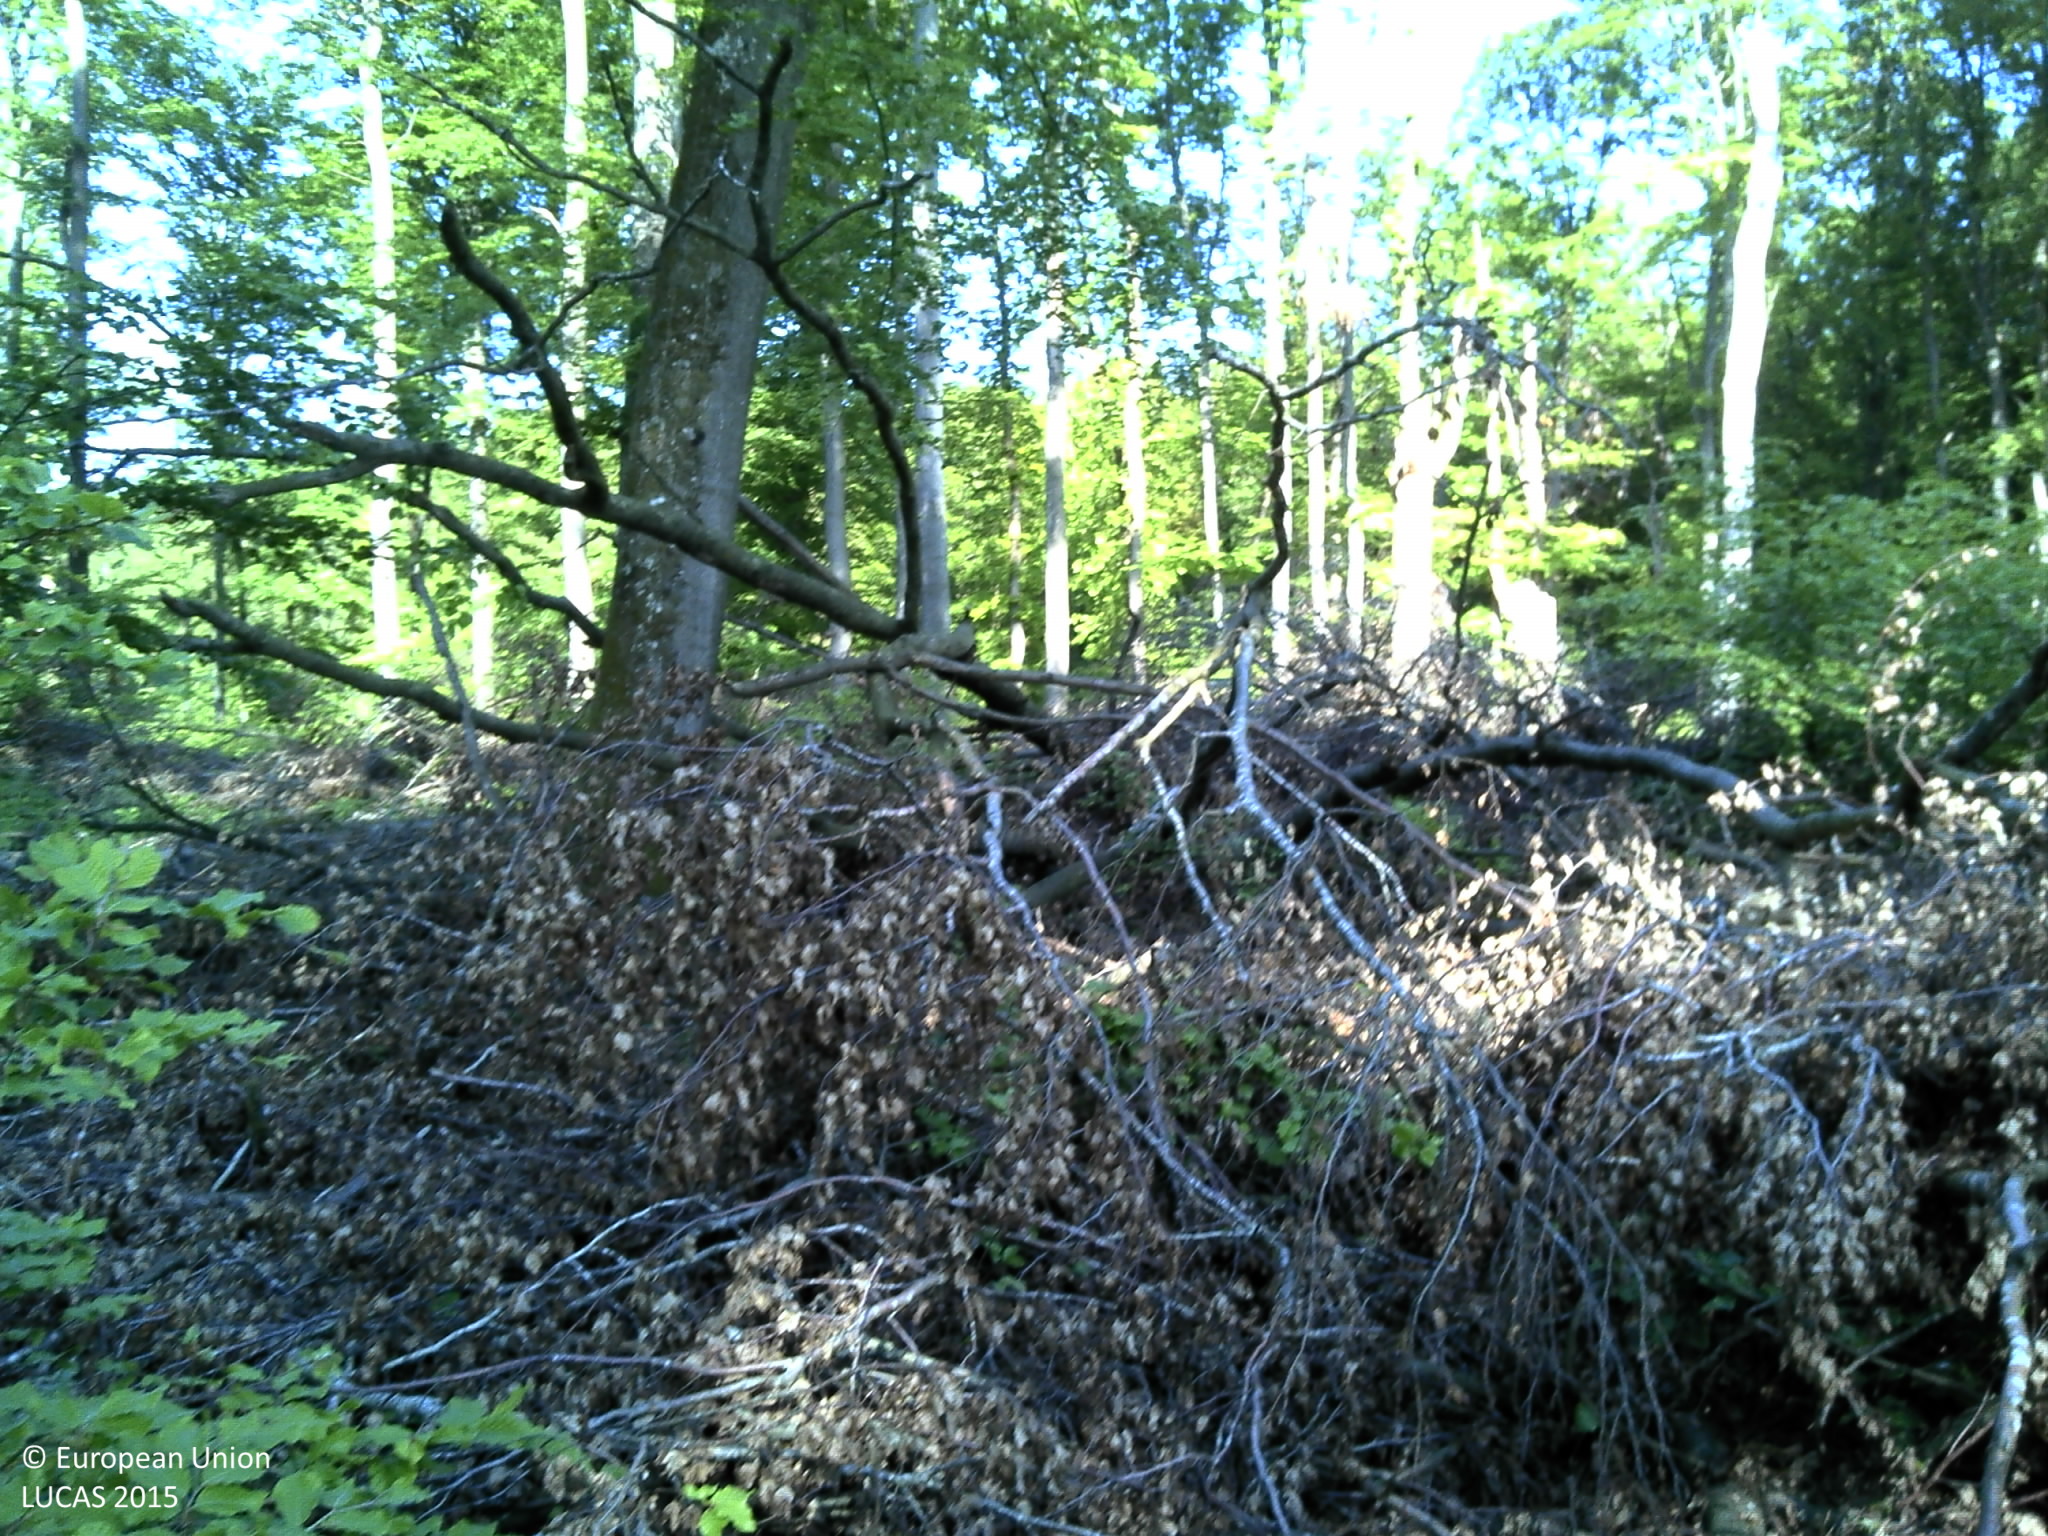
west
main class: Woodland
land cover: Broadleaved woodland
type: beech forest
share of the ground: > 75 %
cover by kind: broadleaved forest trees 100 %
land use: Forestry
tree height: > 5 m
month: May
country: LU
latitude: 49.6808
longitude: 5.9661
